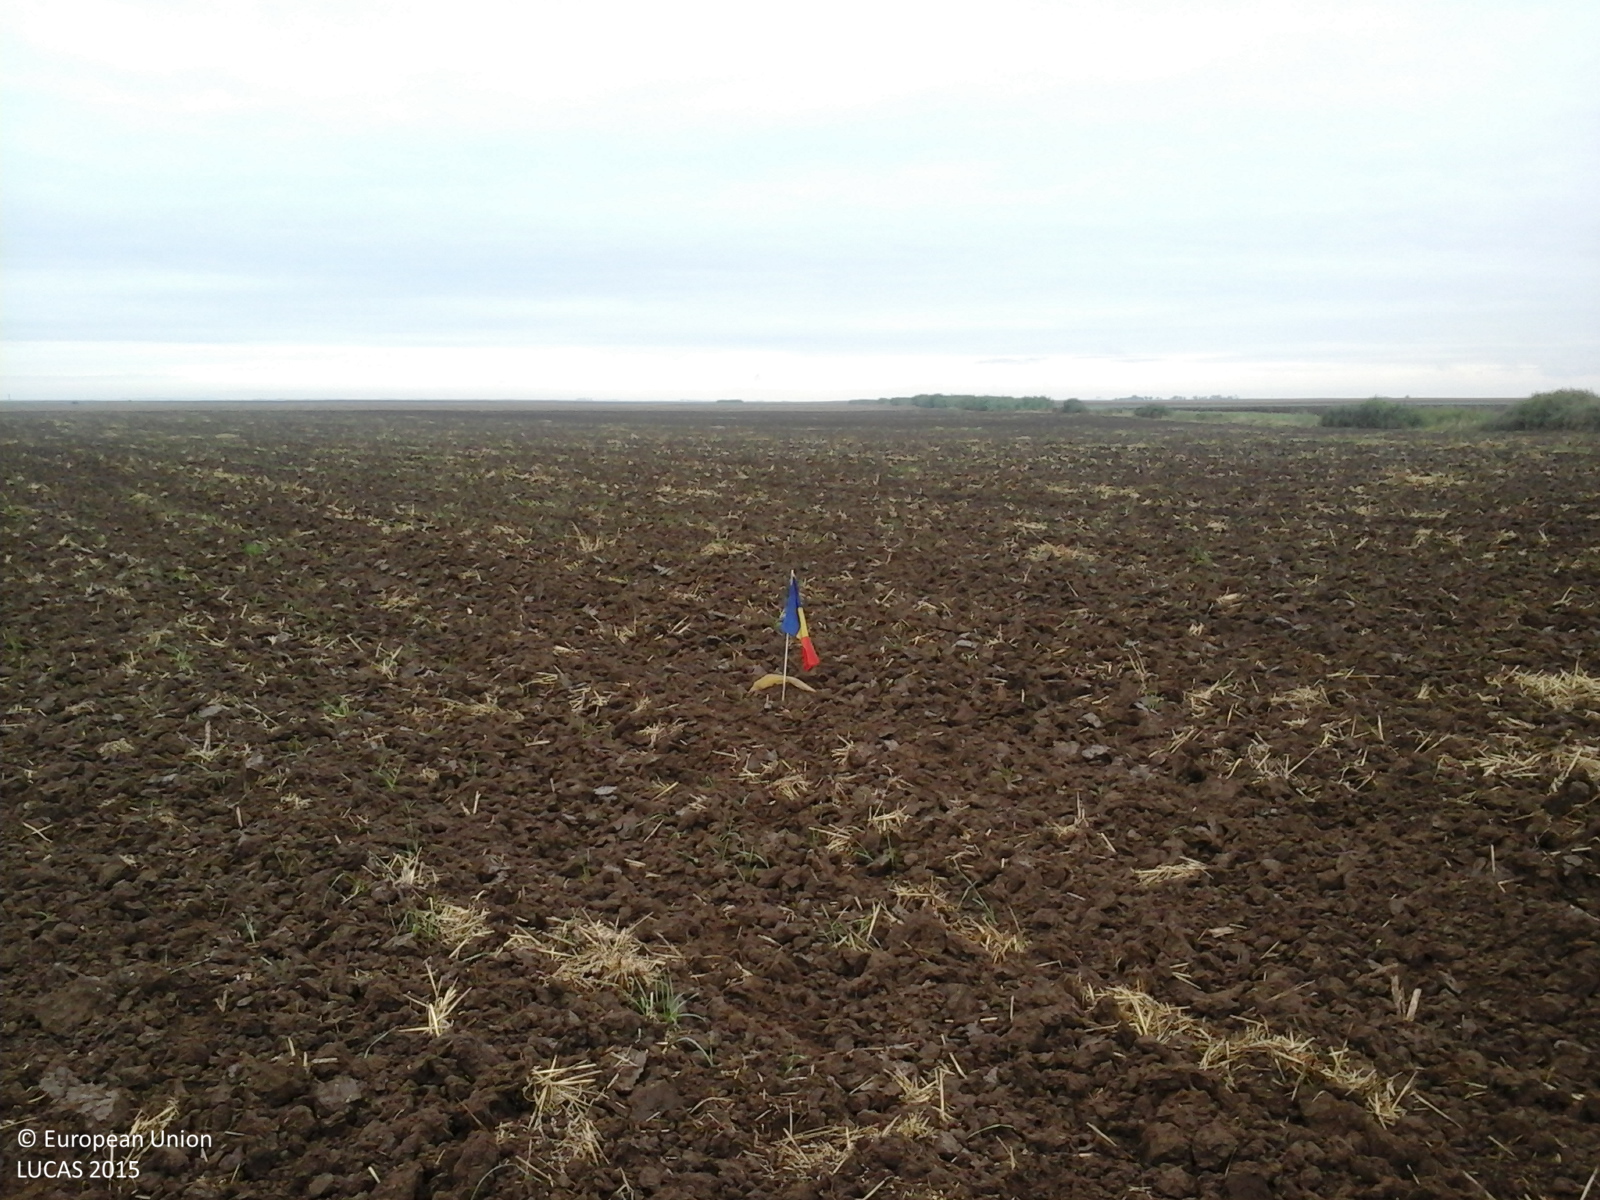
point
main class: Cropland
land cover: Common wheat
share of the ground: < 10 %
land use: Agriculture (excluding fallow land and kitchen gardens)
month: September
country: RO
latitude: 46.9916
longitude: 21.7595
